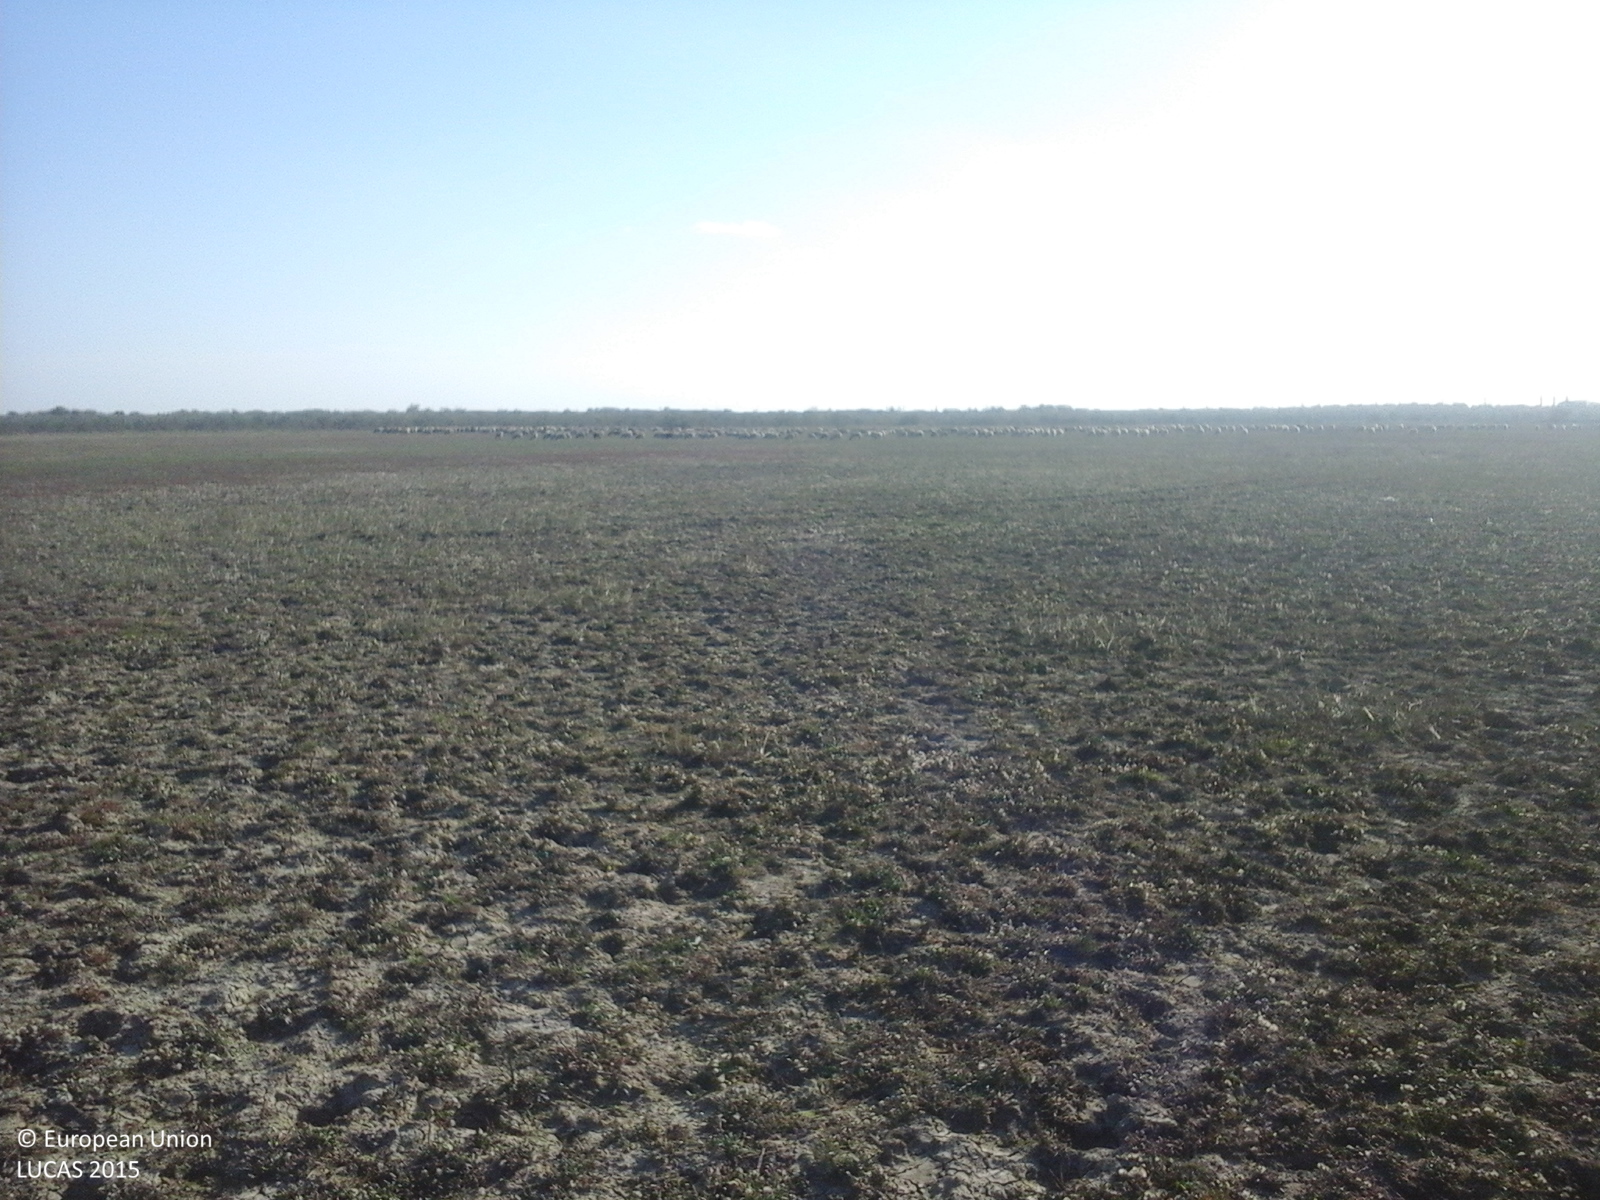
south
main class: Grassland
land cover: Grassland without tree/shrub cover
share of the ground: > 75 %
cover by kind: herbaceous plants 100 %
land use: Agriculture (excluding fallow land and kitchen gardens)
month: October
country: RO
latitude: 45.2181
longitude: 27.3241
